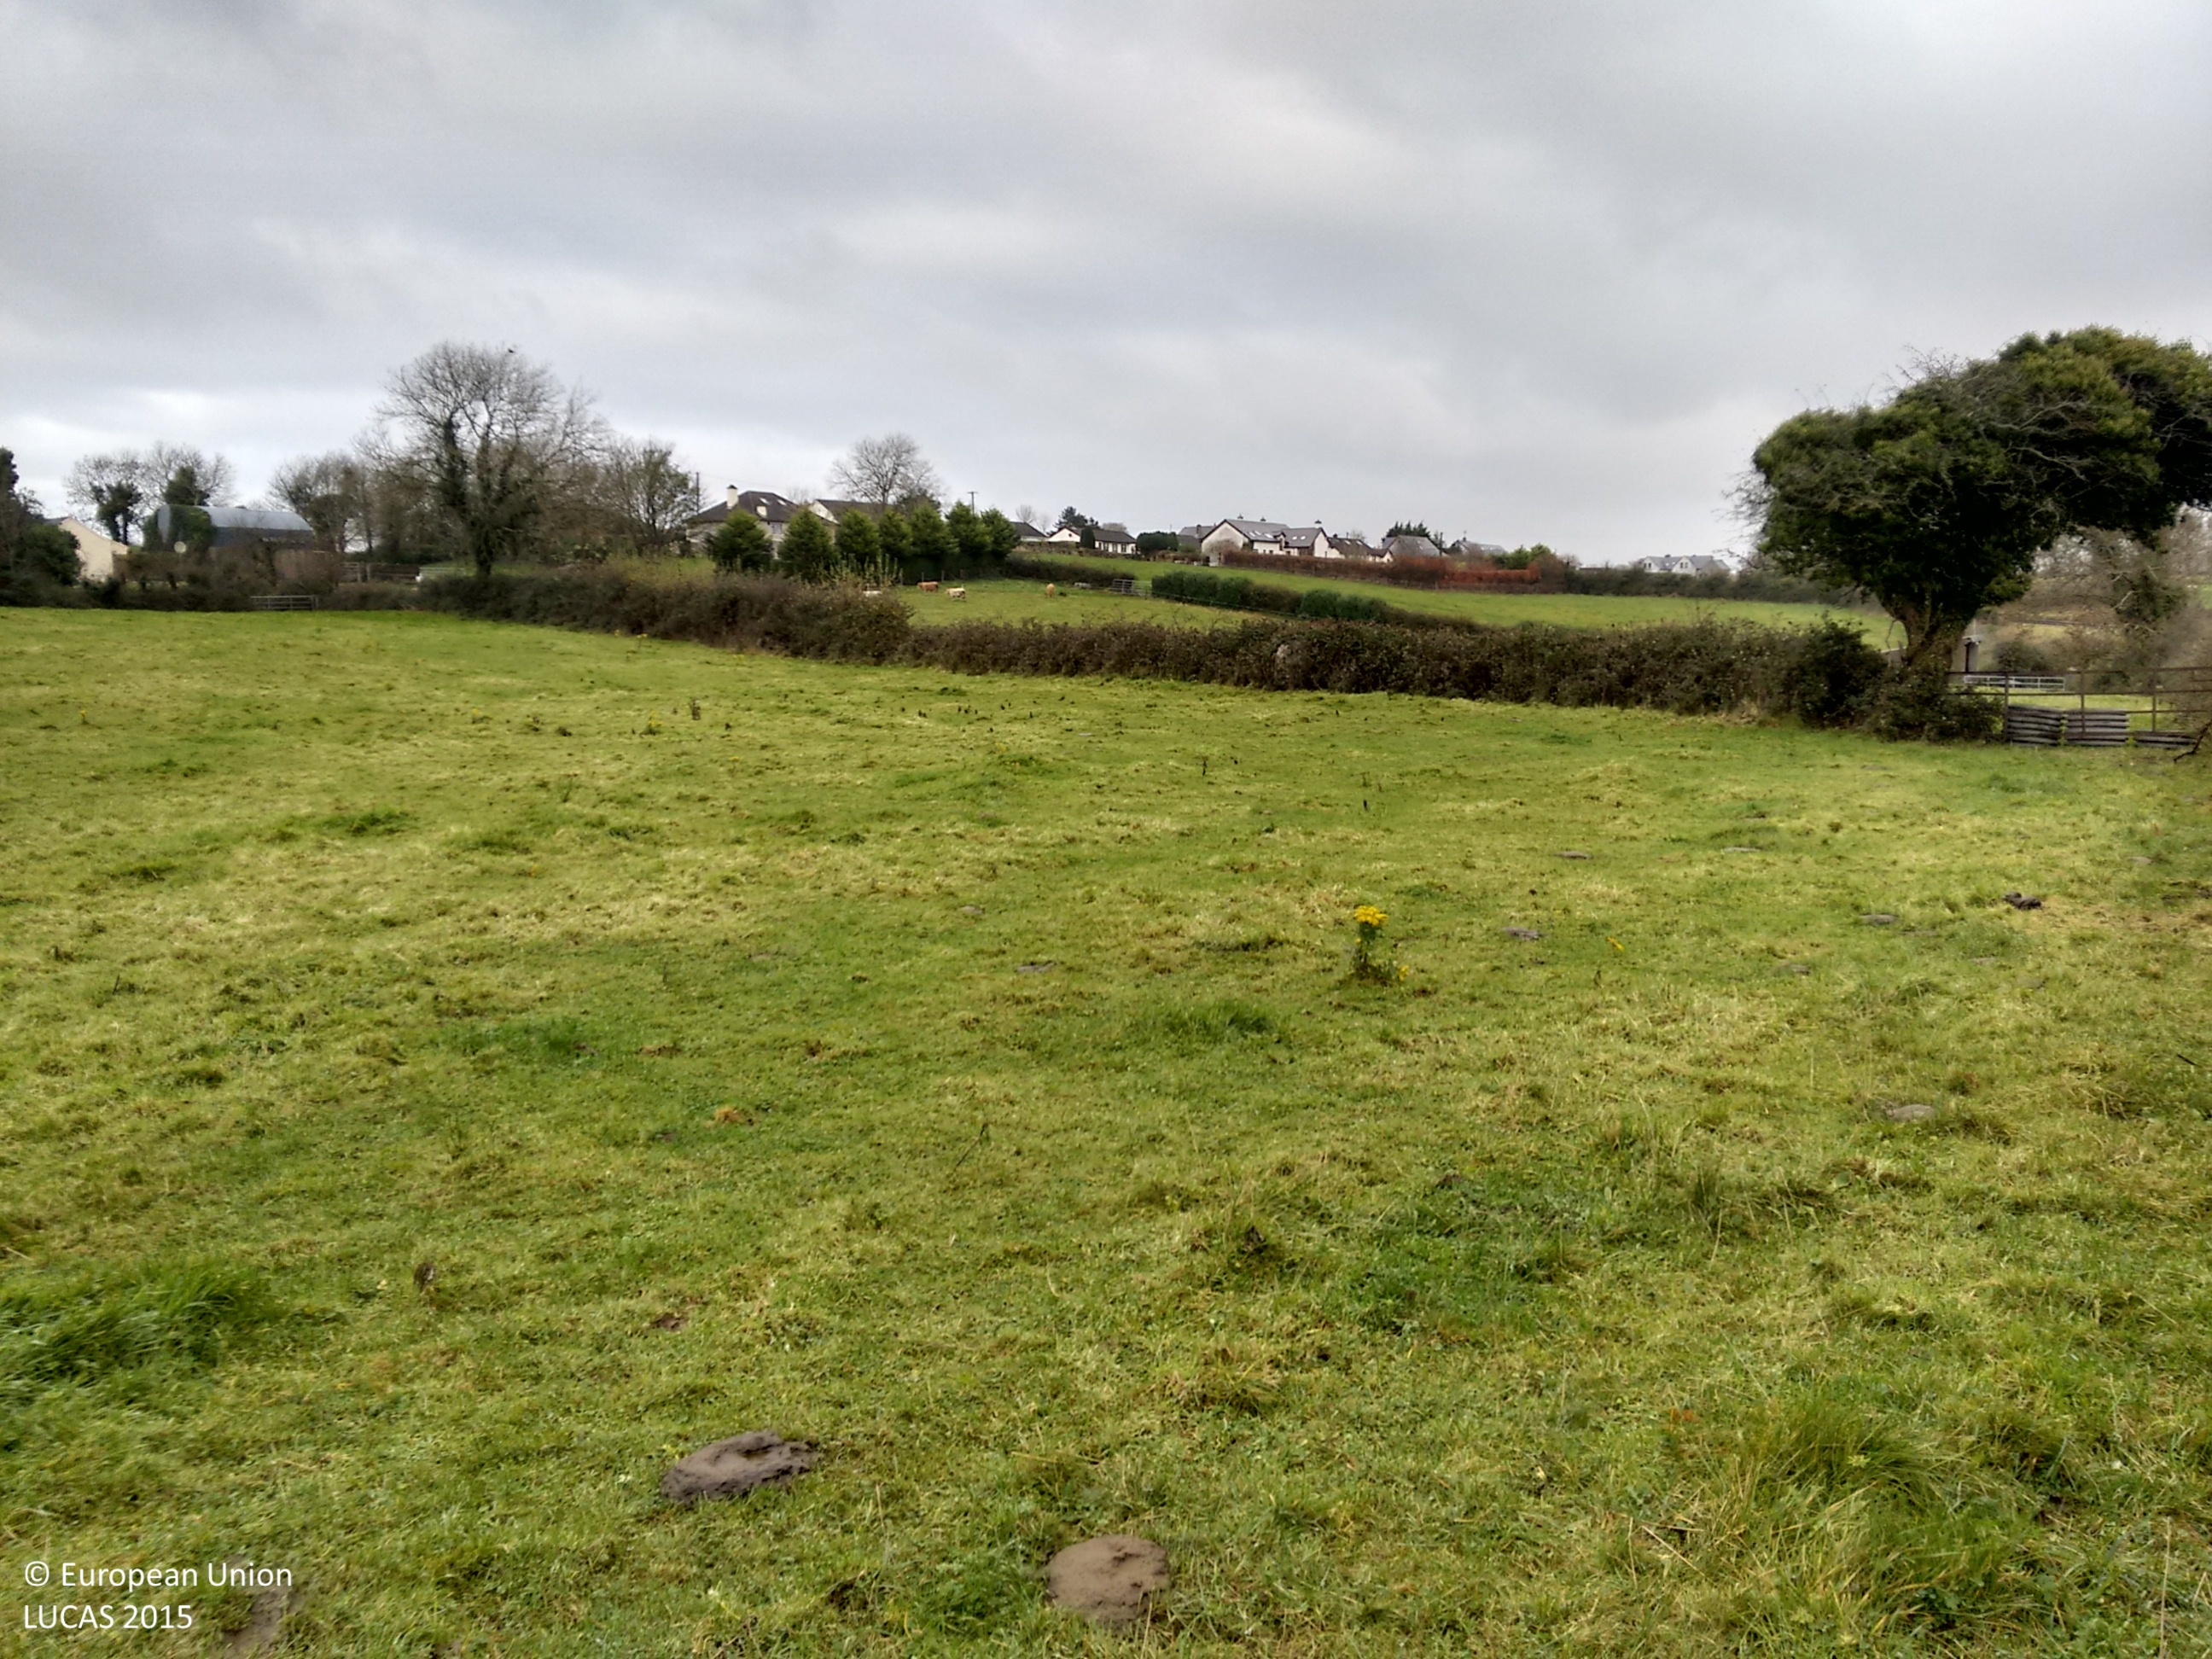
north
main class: Grassland
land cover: Grassland without tree/shrub cover
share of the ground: > 75 %
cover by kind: herbaceous plants 100 %
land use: Railway transport
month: November
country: IE
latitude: 54.2325
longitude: -8.4938
